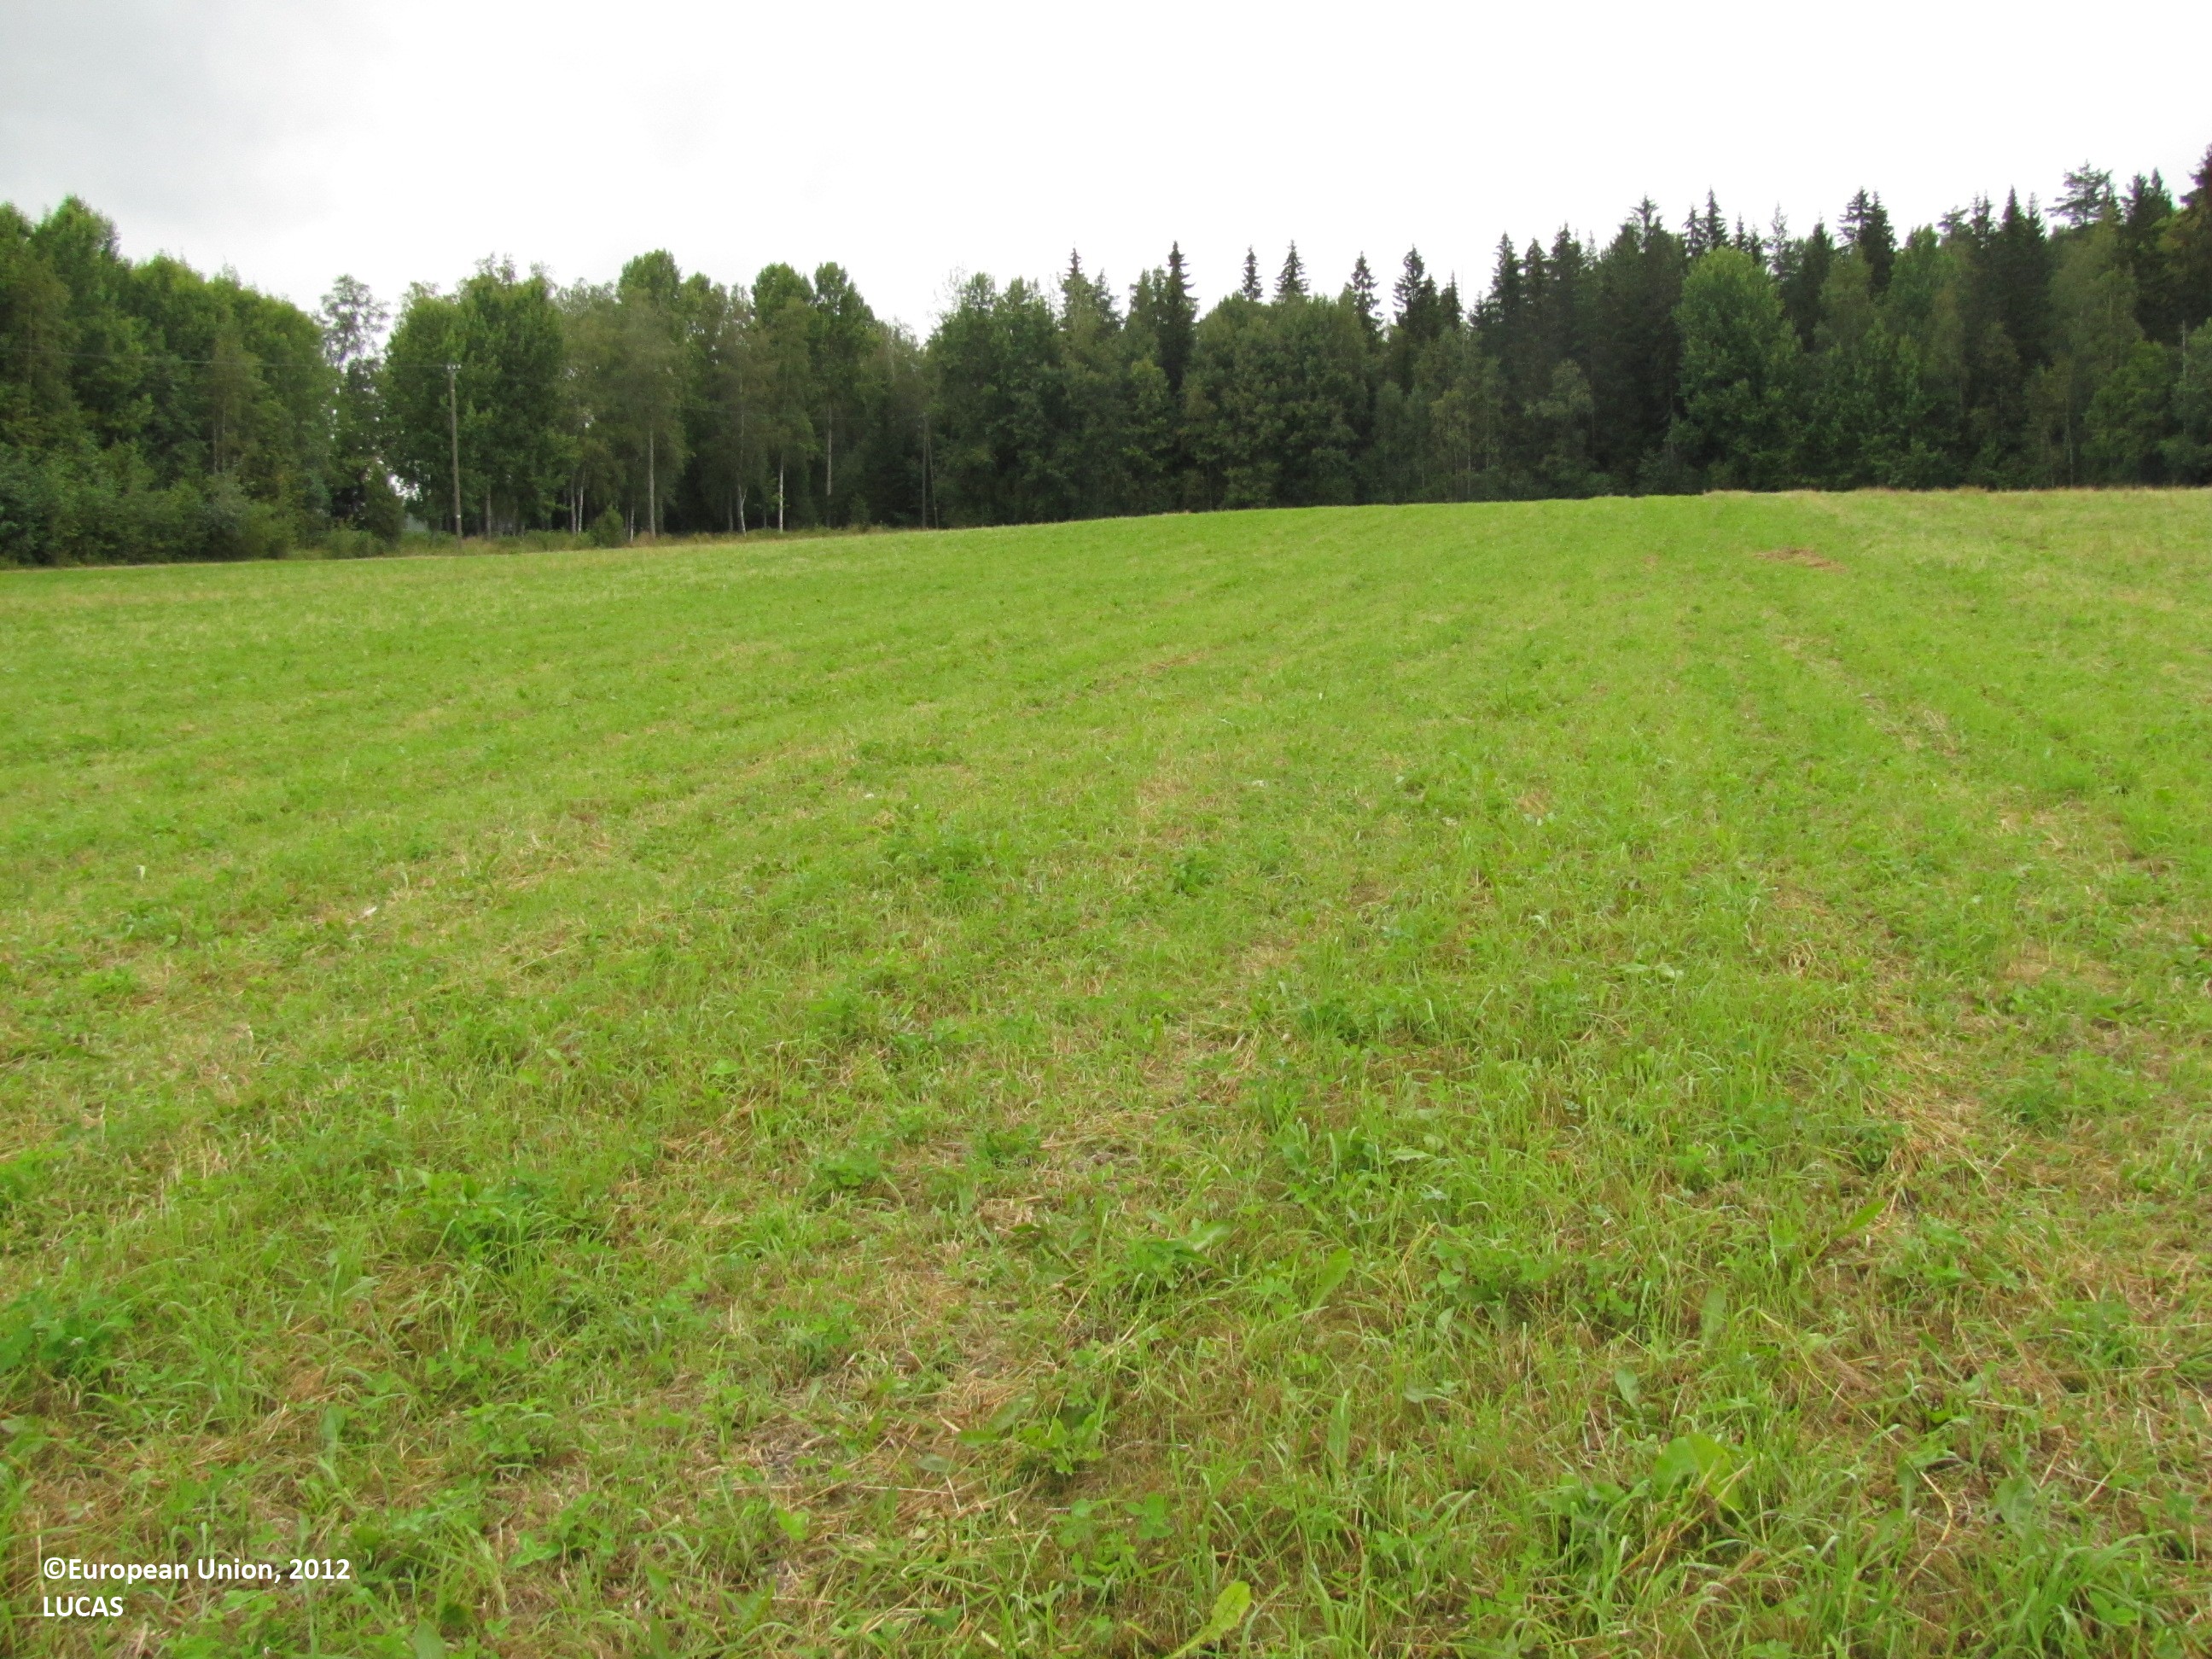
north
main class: Cropland
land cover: Temporary grasslands
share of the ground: > 75 %
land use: Agriculture (excluding fallow land and kitchen gardens)
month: August
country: FI
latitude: 61.5469
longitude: 23.6473
